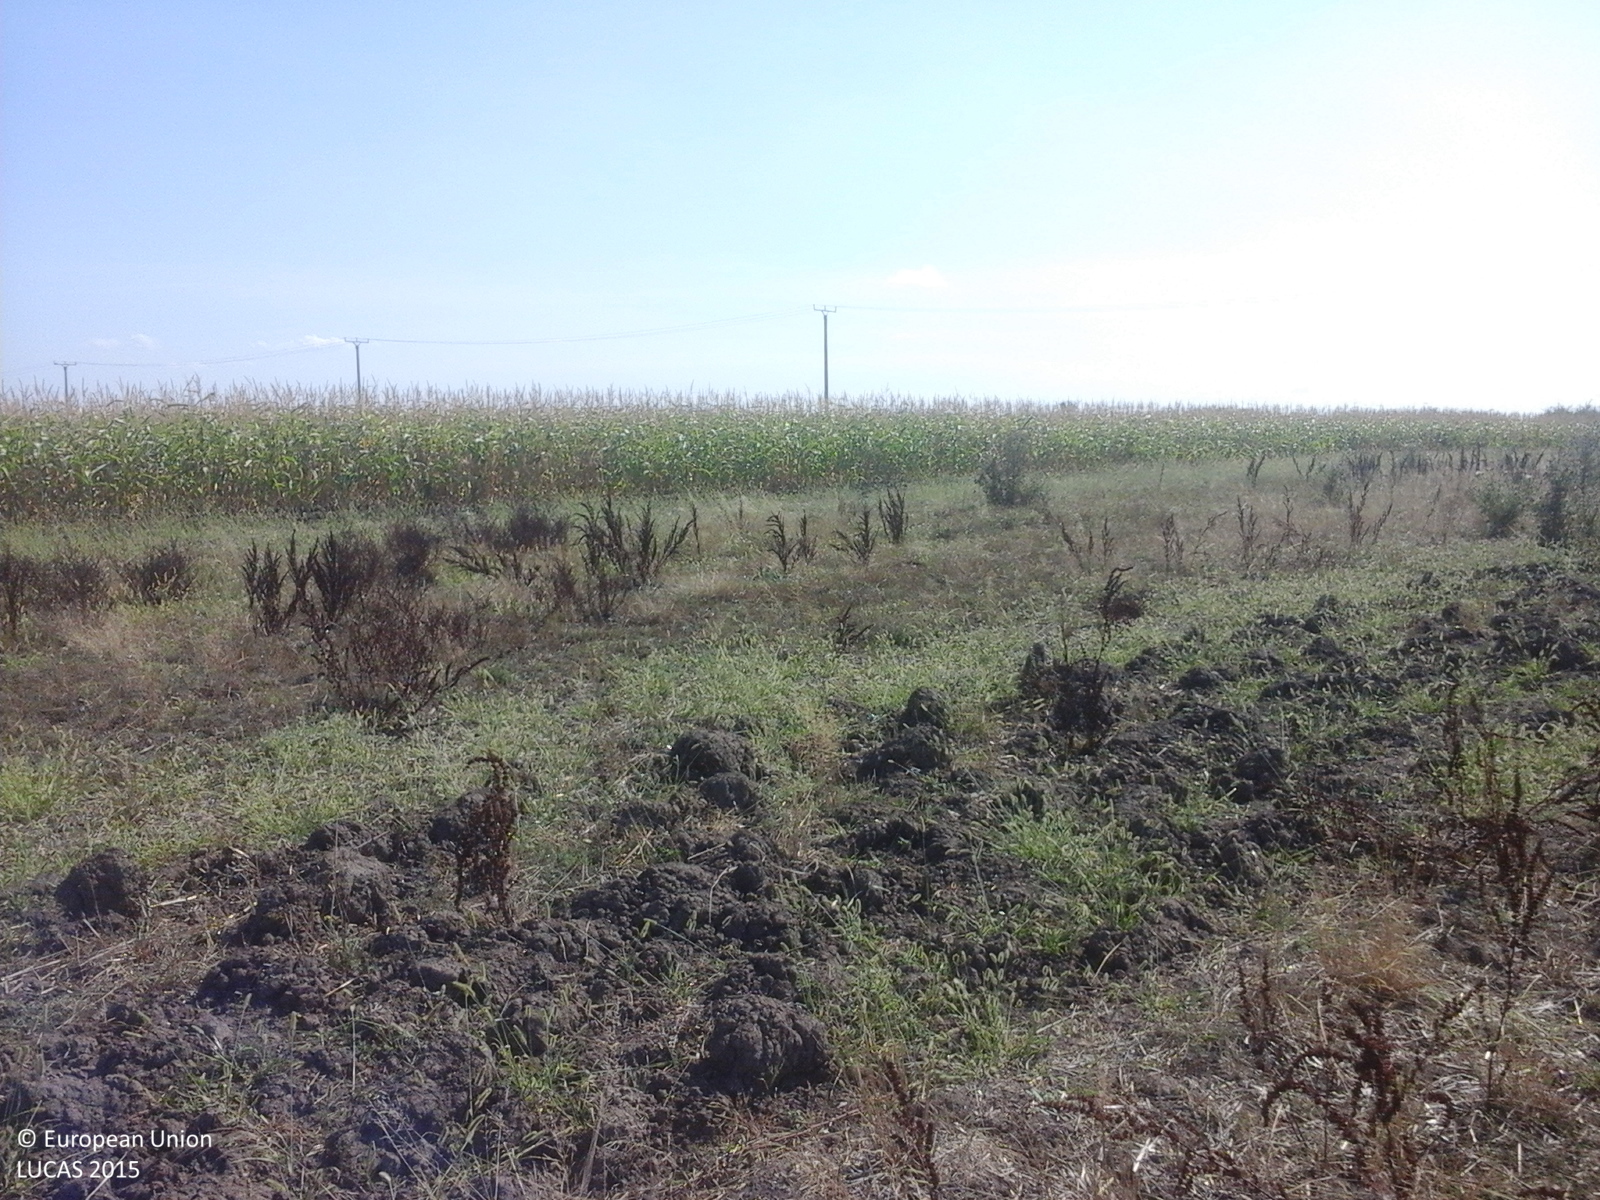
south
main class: Grassland
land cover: Spontaneously vegetated surfaces
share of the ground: > 75 %
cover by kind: herbaceous plants 100 %
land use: Fallow land
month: August
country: RO
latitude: 45.3517
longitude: 21.4548
